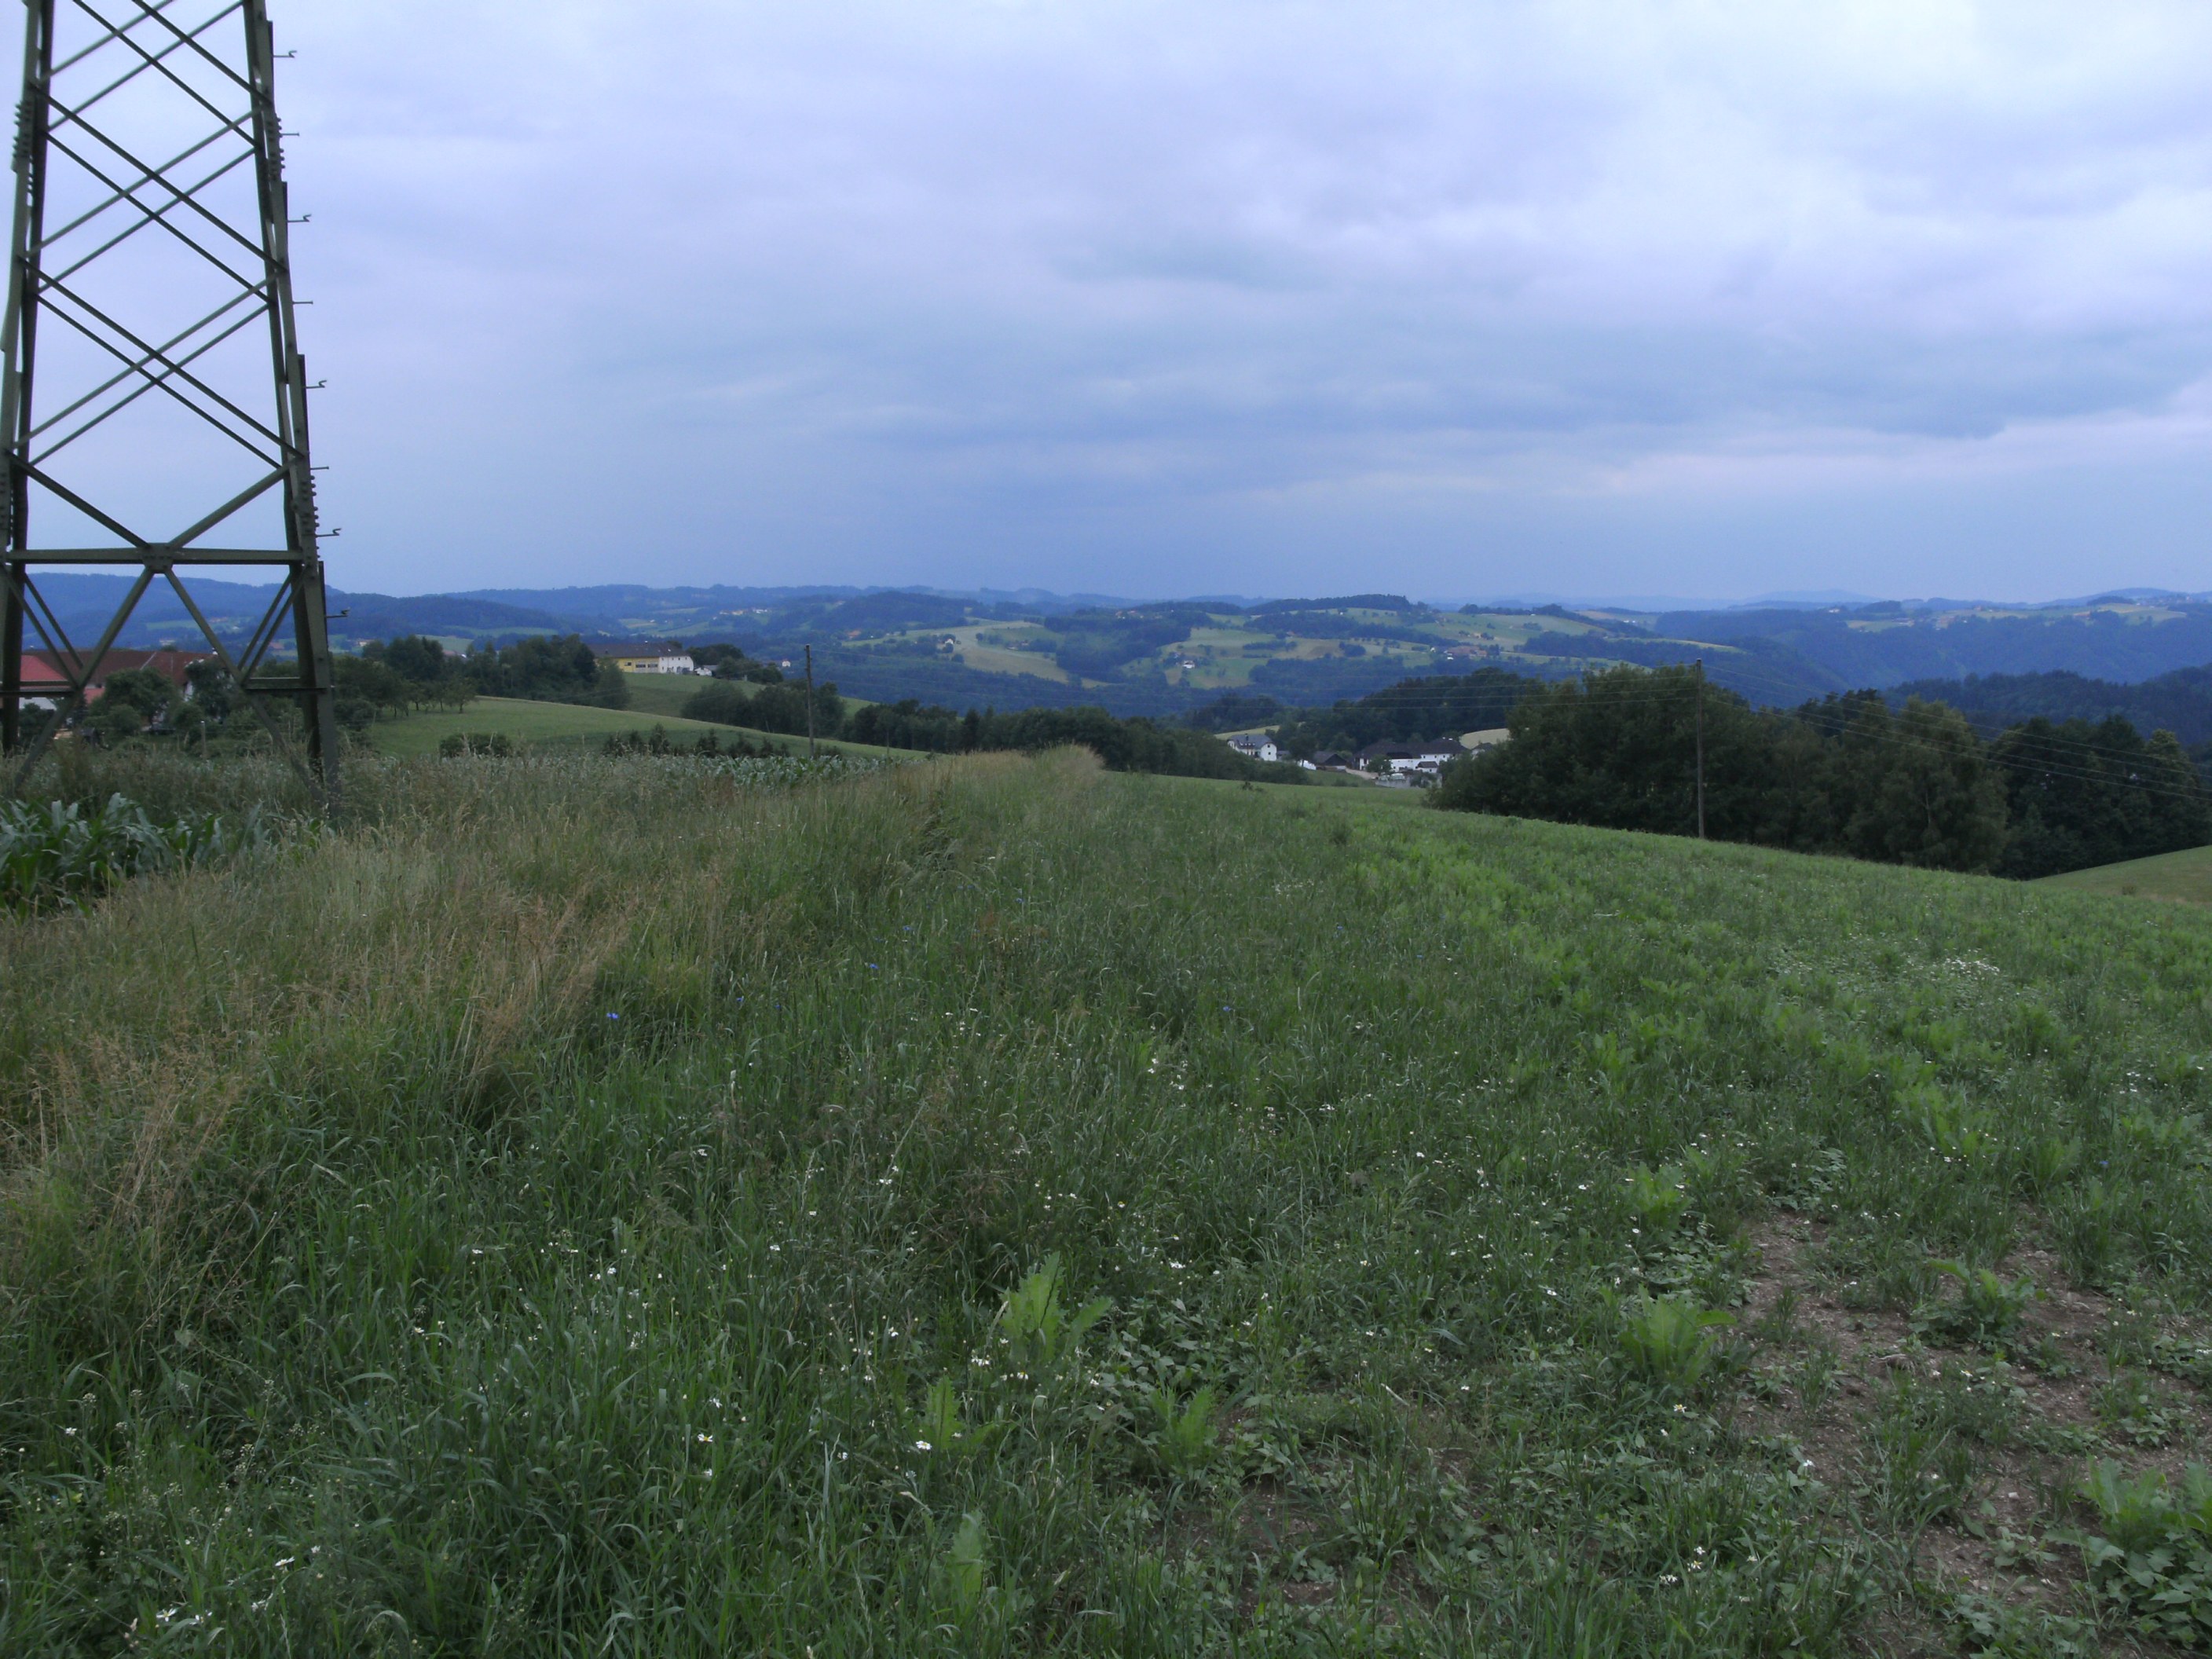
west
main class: Cropland
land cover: Other fibre and oleaginous crops
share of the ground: 25 - 50 %
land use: Agriculture (excluding fallow land and kitchen gardens)
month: June
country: AT
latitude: 48.4018
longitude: 14.0387
